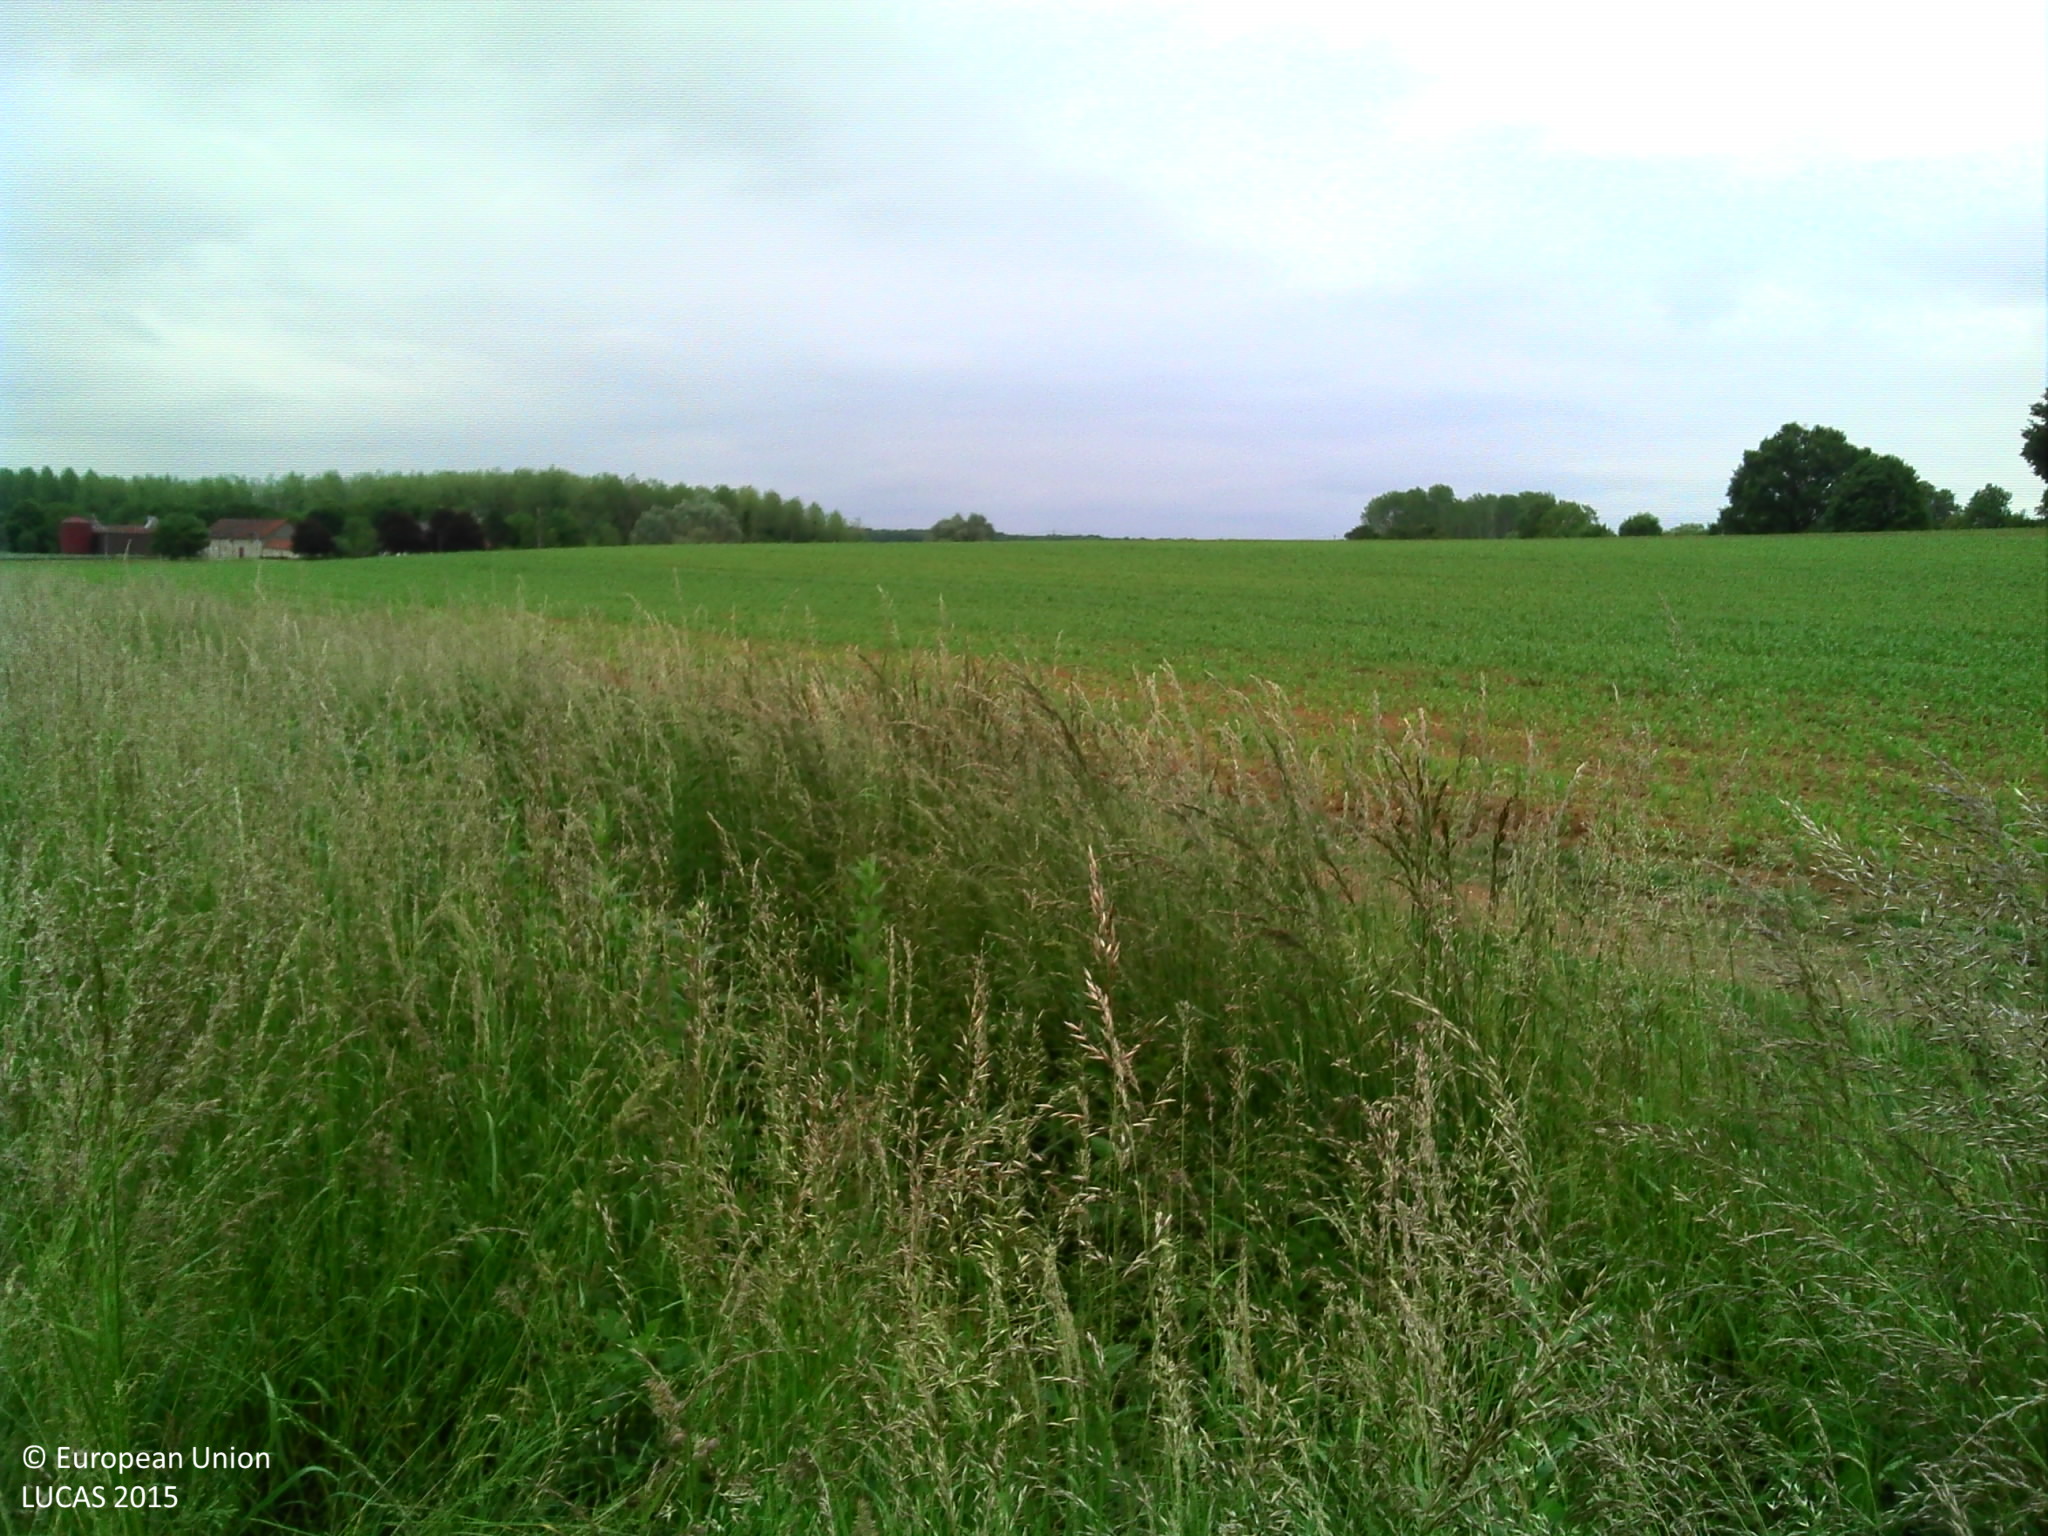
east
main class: Grassland
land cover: Grassland without tree/shrub cover
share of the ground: > 75 %
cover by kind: herbaceous plants 100 %
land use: Agriculture (excluding fallow land and kitchen gardens)
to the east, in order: Grassland without tree/shrub cover; Ditches and canals; Tracks; Maize
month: May
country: FR
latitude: 47.1463
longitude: 2.9134
